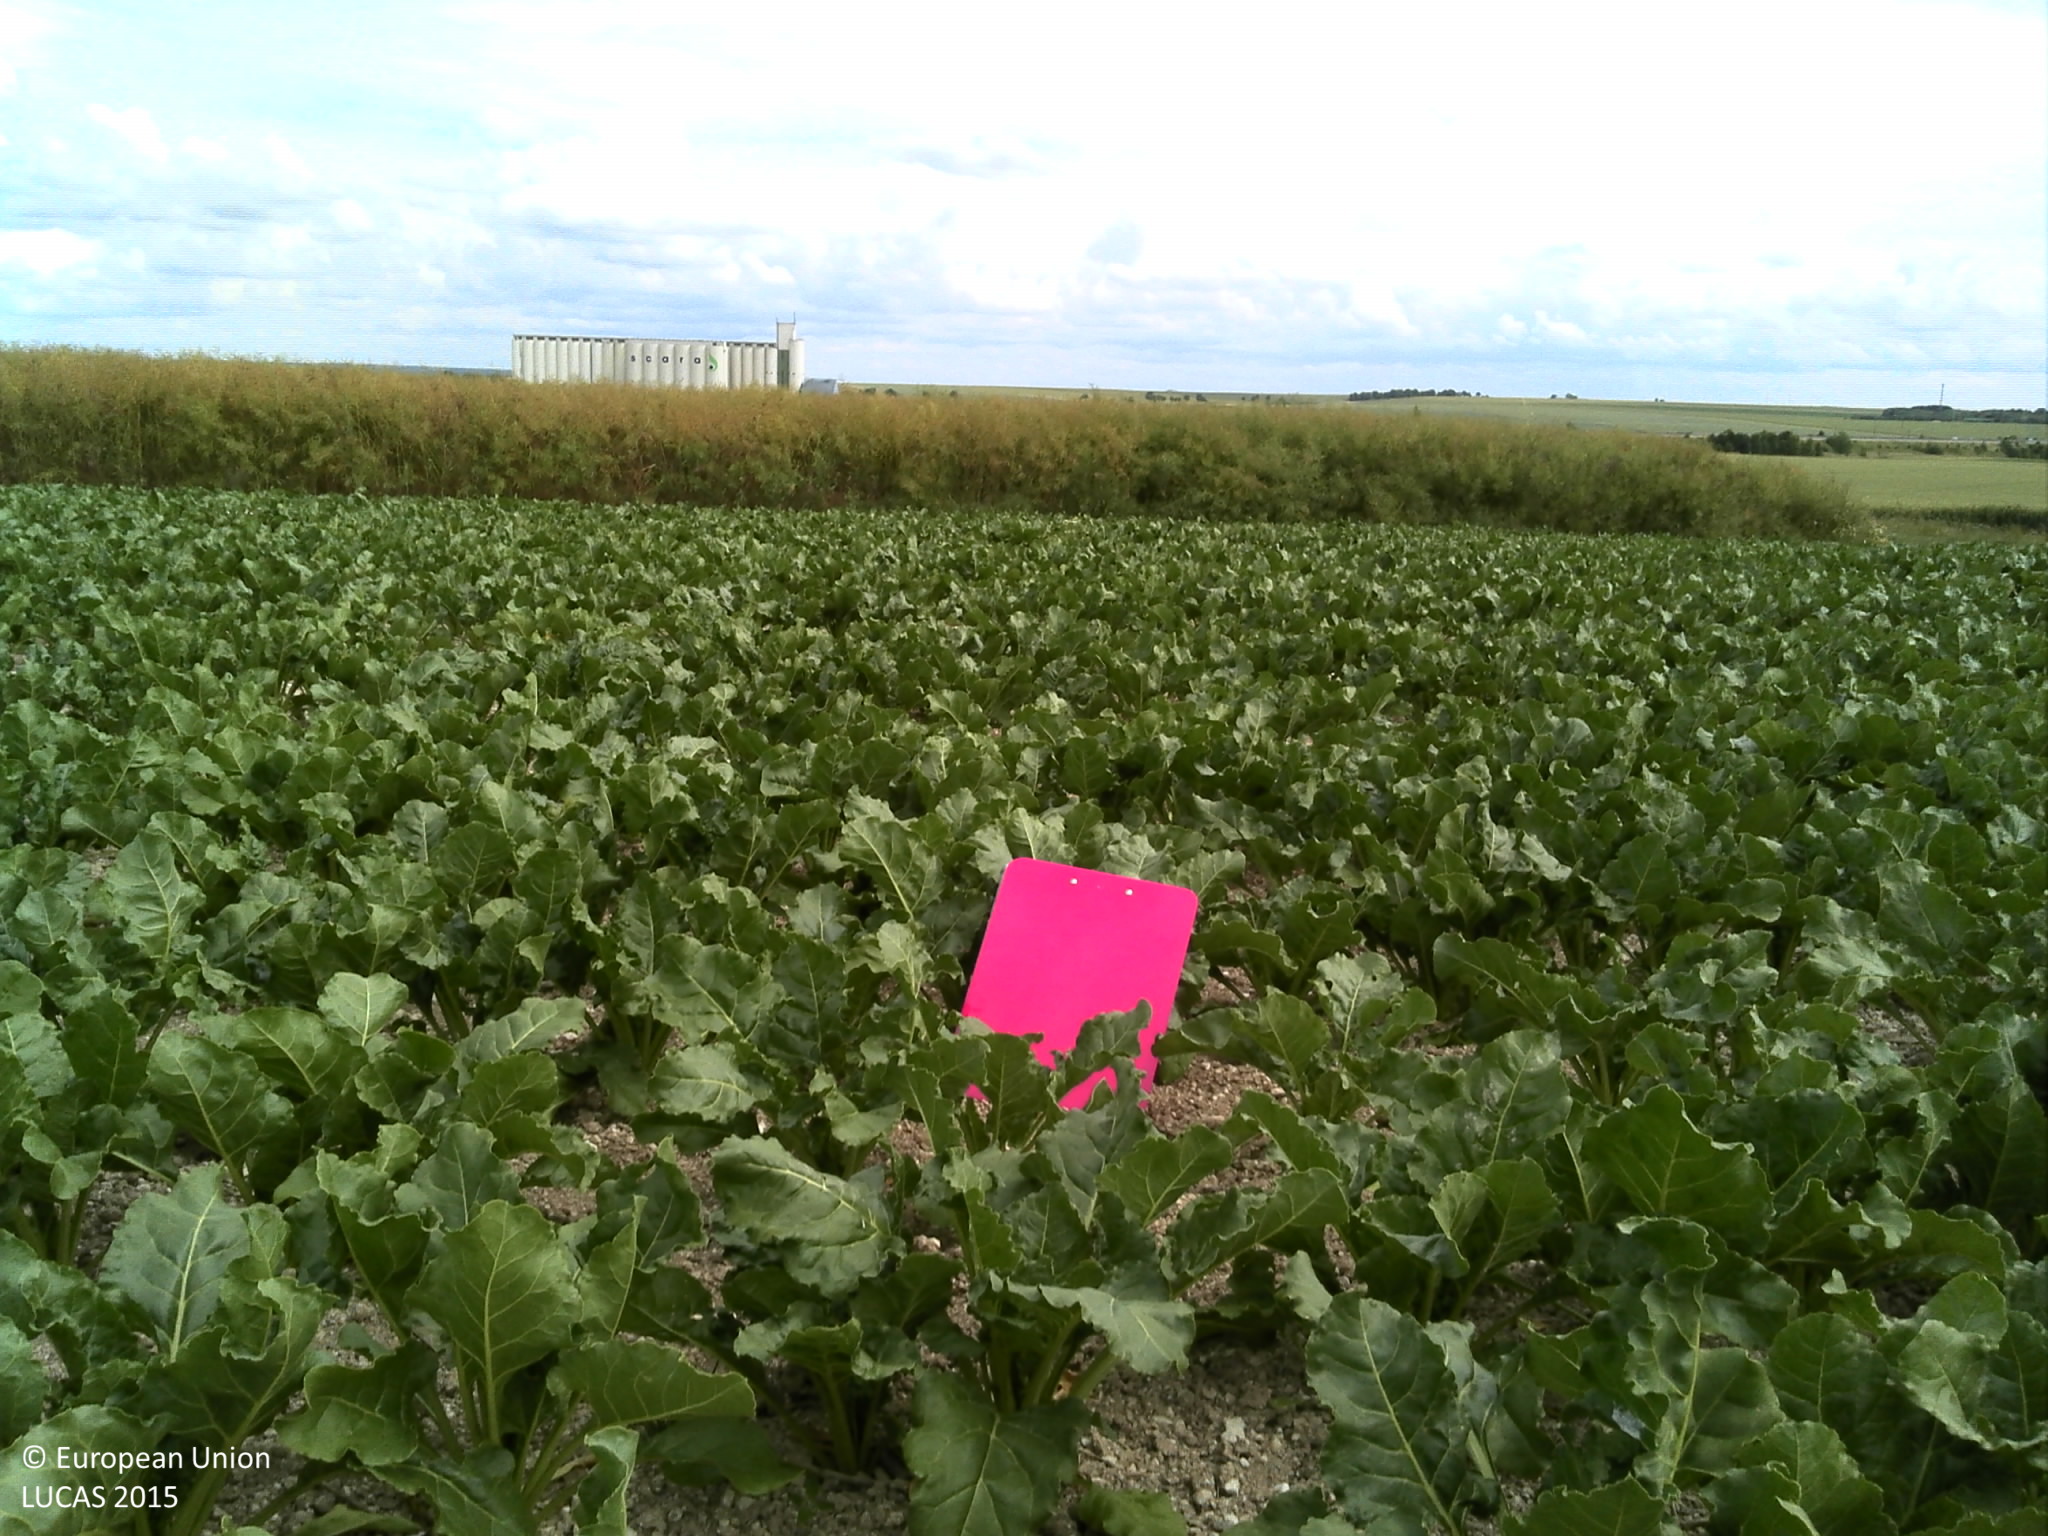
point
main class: Cropland
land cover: Sugar beet
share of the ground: 50 - 75 %
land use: Agriculture (excluding fallow land and kitchen gardens)
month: June
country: FR
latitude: 48.6826
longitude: 4.1691
